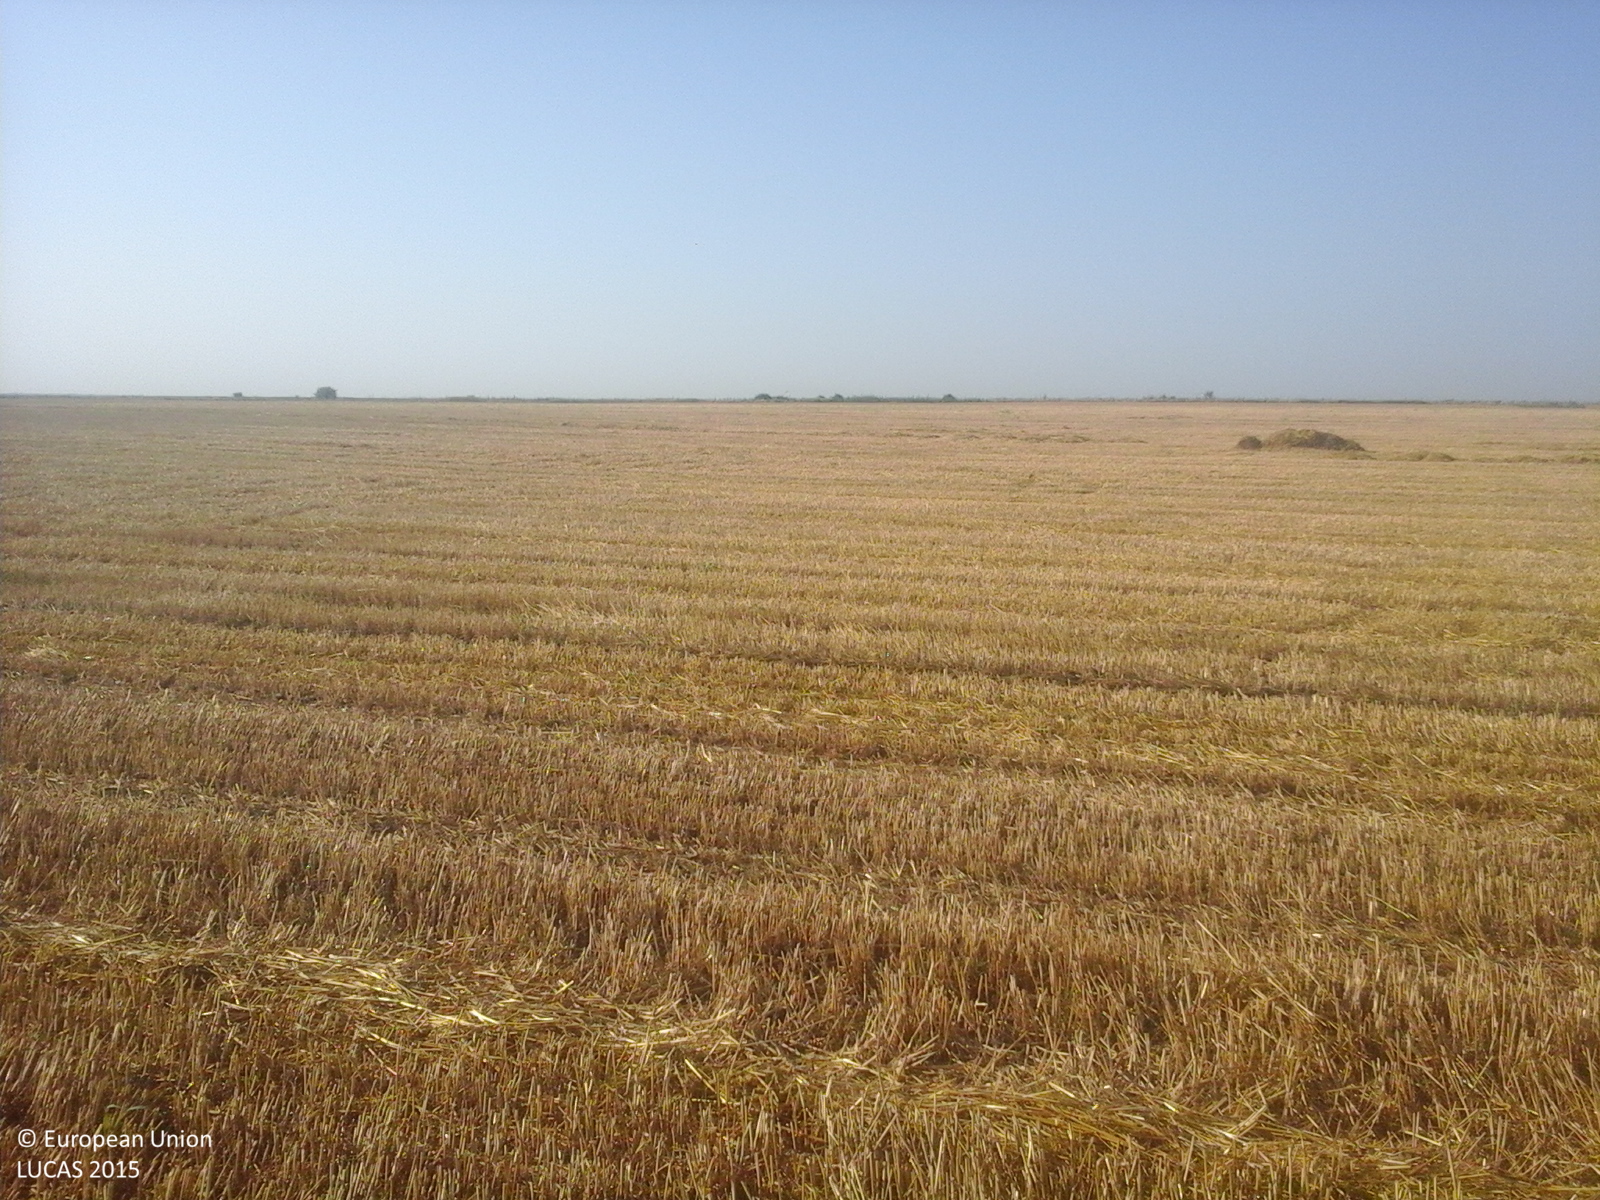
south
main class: Cropland
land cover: Durum wheat
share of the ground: 10 - 25 %
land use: Agriculture (excluding fallow land and kitchen gardens)
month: July
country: RO
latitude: 44.3850
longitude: 27.2431
